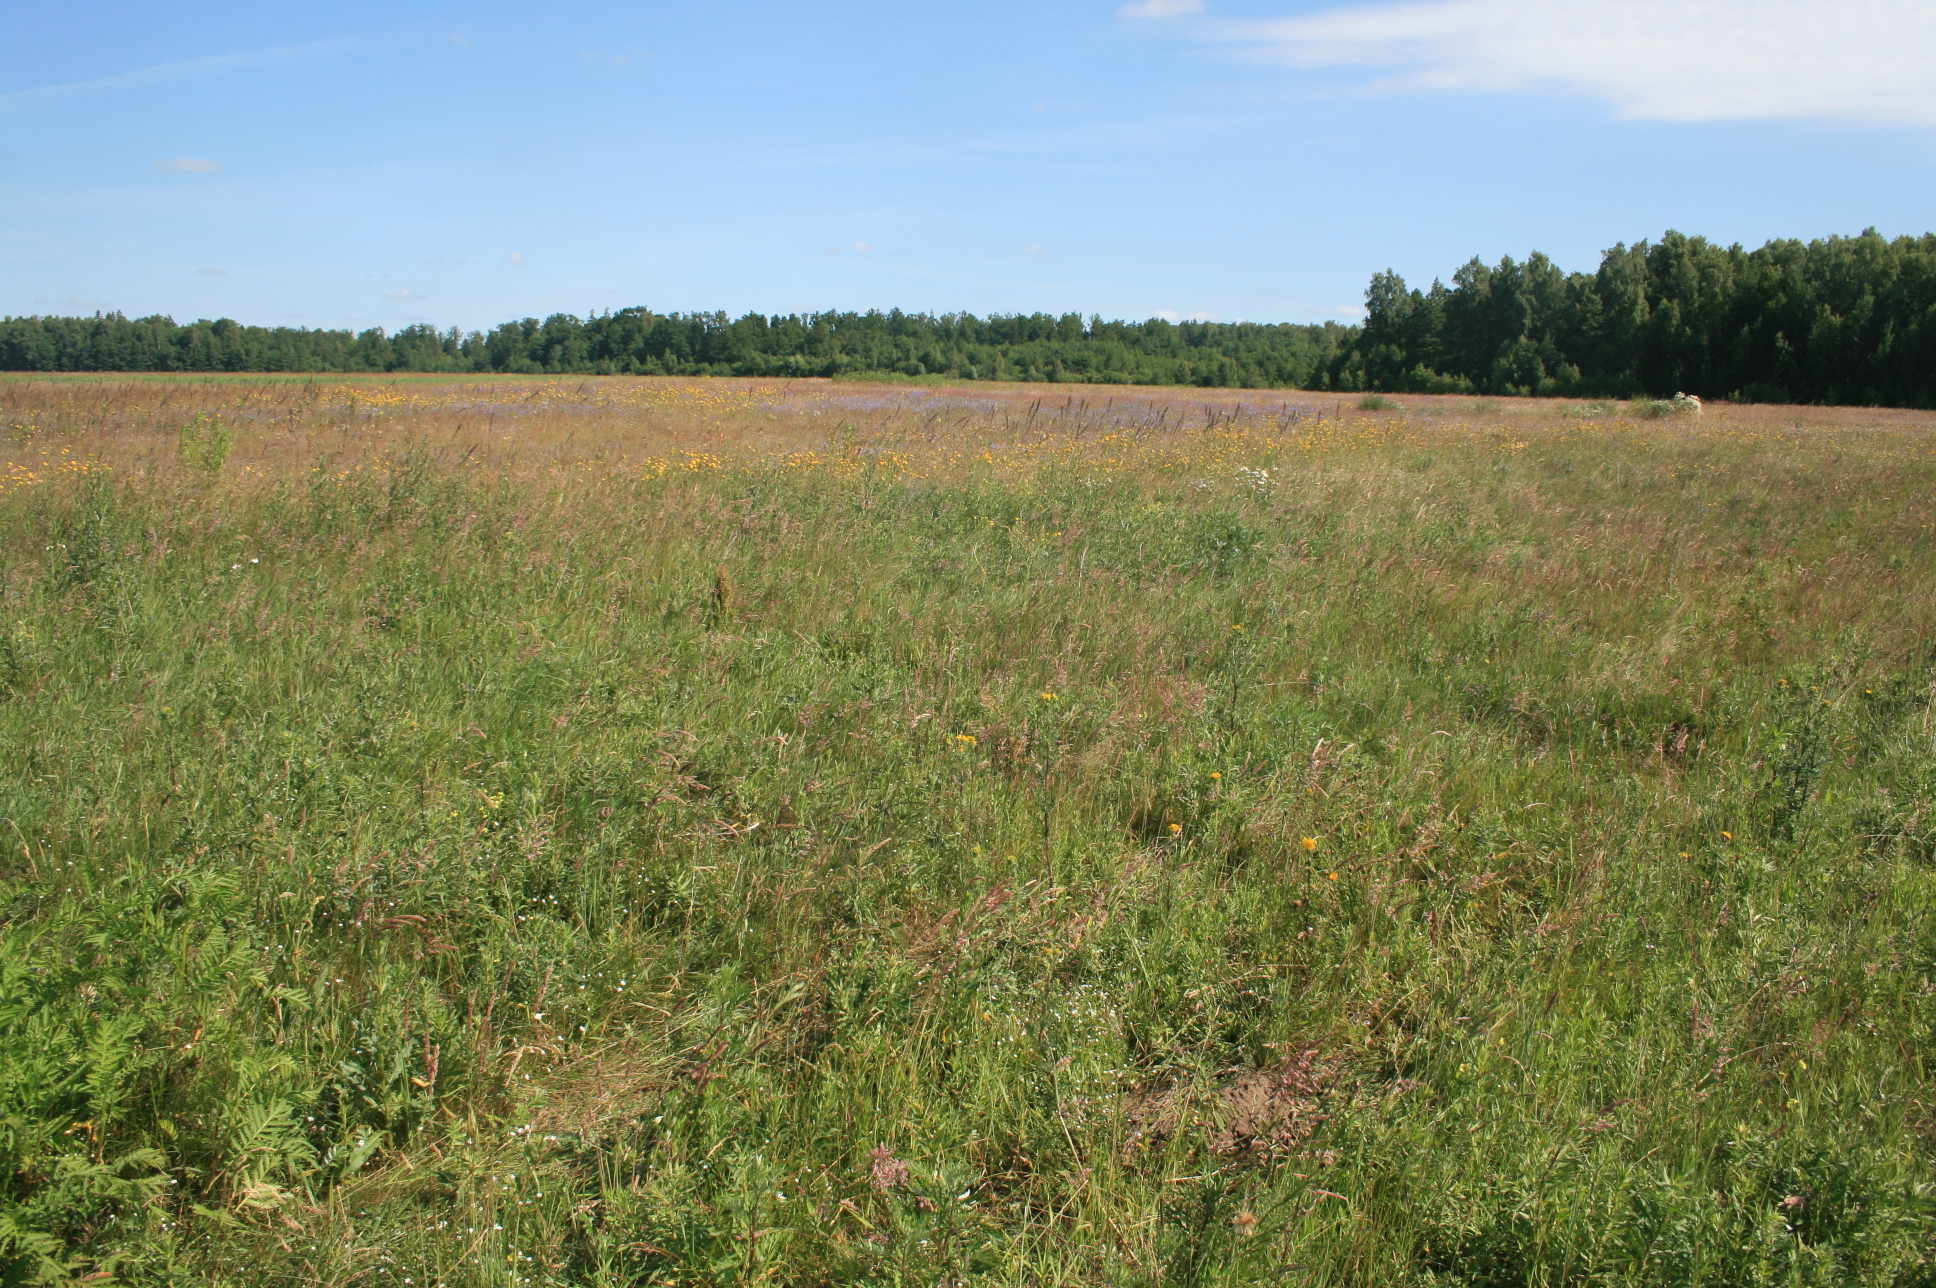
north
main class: Grassland
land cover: Grassland without tree/shrub cover
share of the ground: > 75 %
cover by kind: herbaceous plants 100 %
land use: Agriculture (excluding fallow land and kitchen gardens)
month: June
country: LT
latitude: 55.2320
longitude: 21.7009
